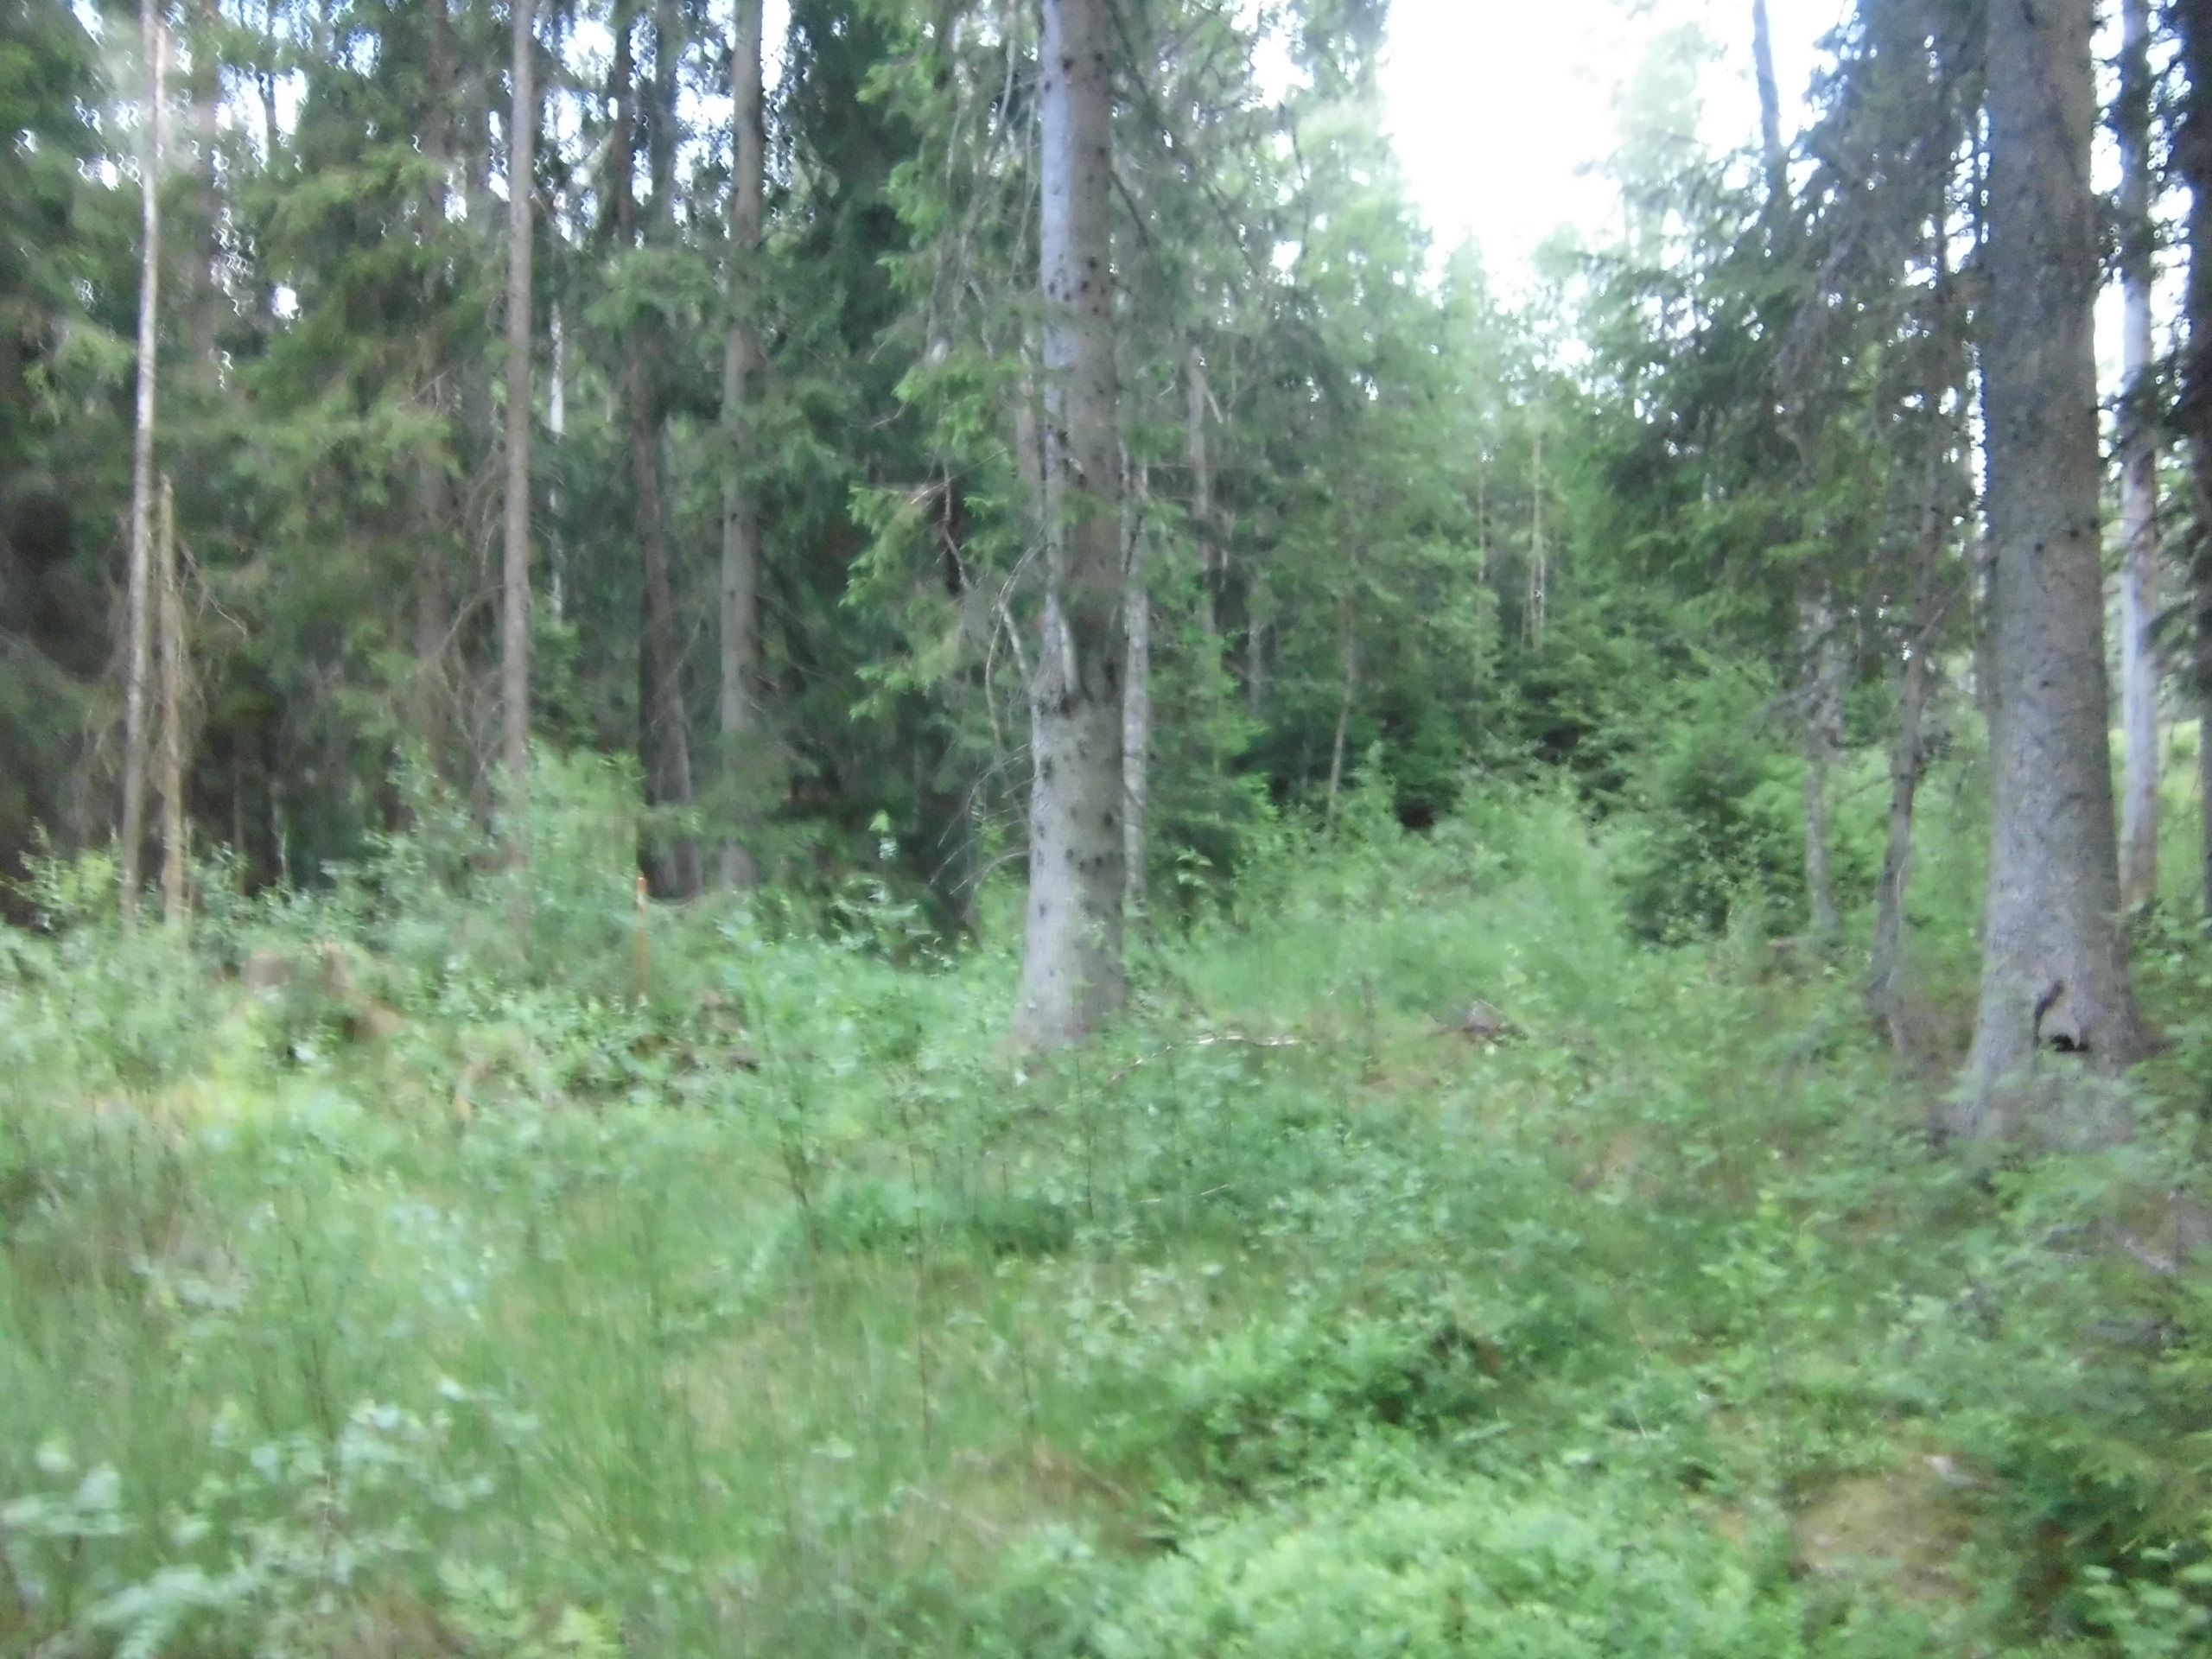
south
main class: Woodland
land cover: Spruce dominated coniferous woodland
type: boreal forest
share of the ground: 50 - 75 %
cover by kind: coniferous forest trees 50 %, herbaceous plants 25 %, shrubs 15 %, broadleaved forest trees 10 %
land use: Forestry
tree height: > 5 m
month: July
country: SE
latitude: 57.2836
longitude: 14.8902
